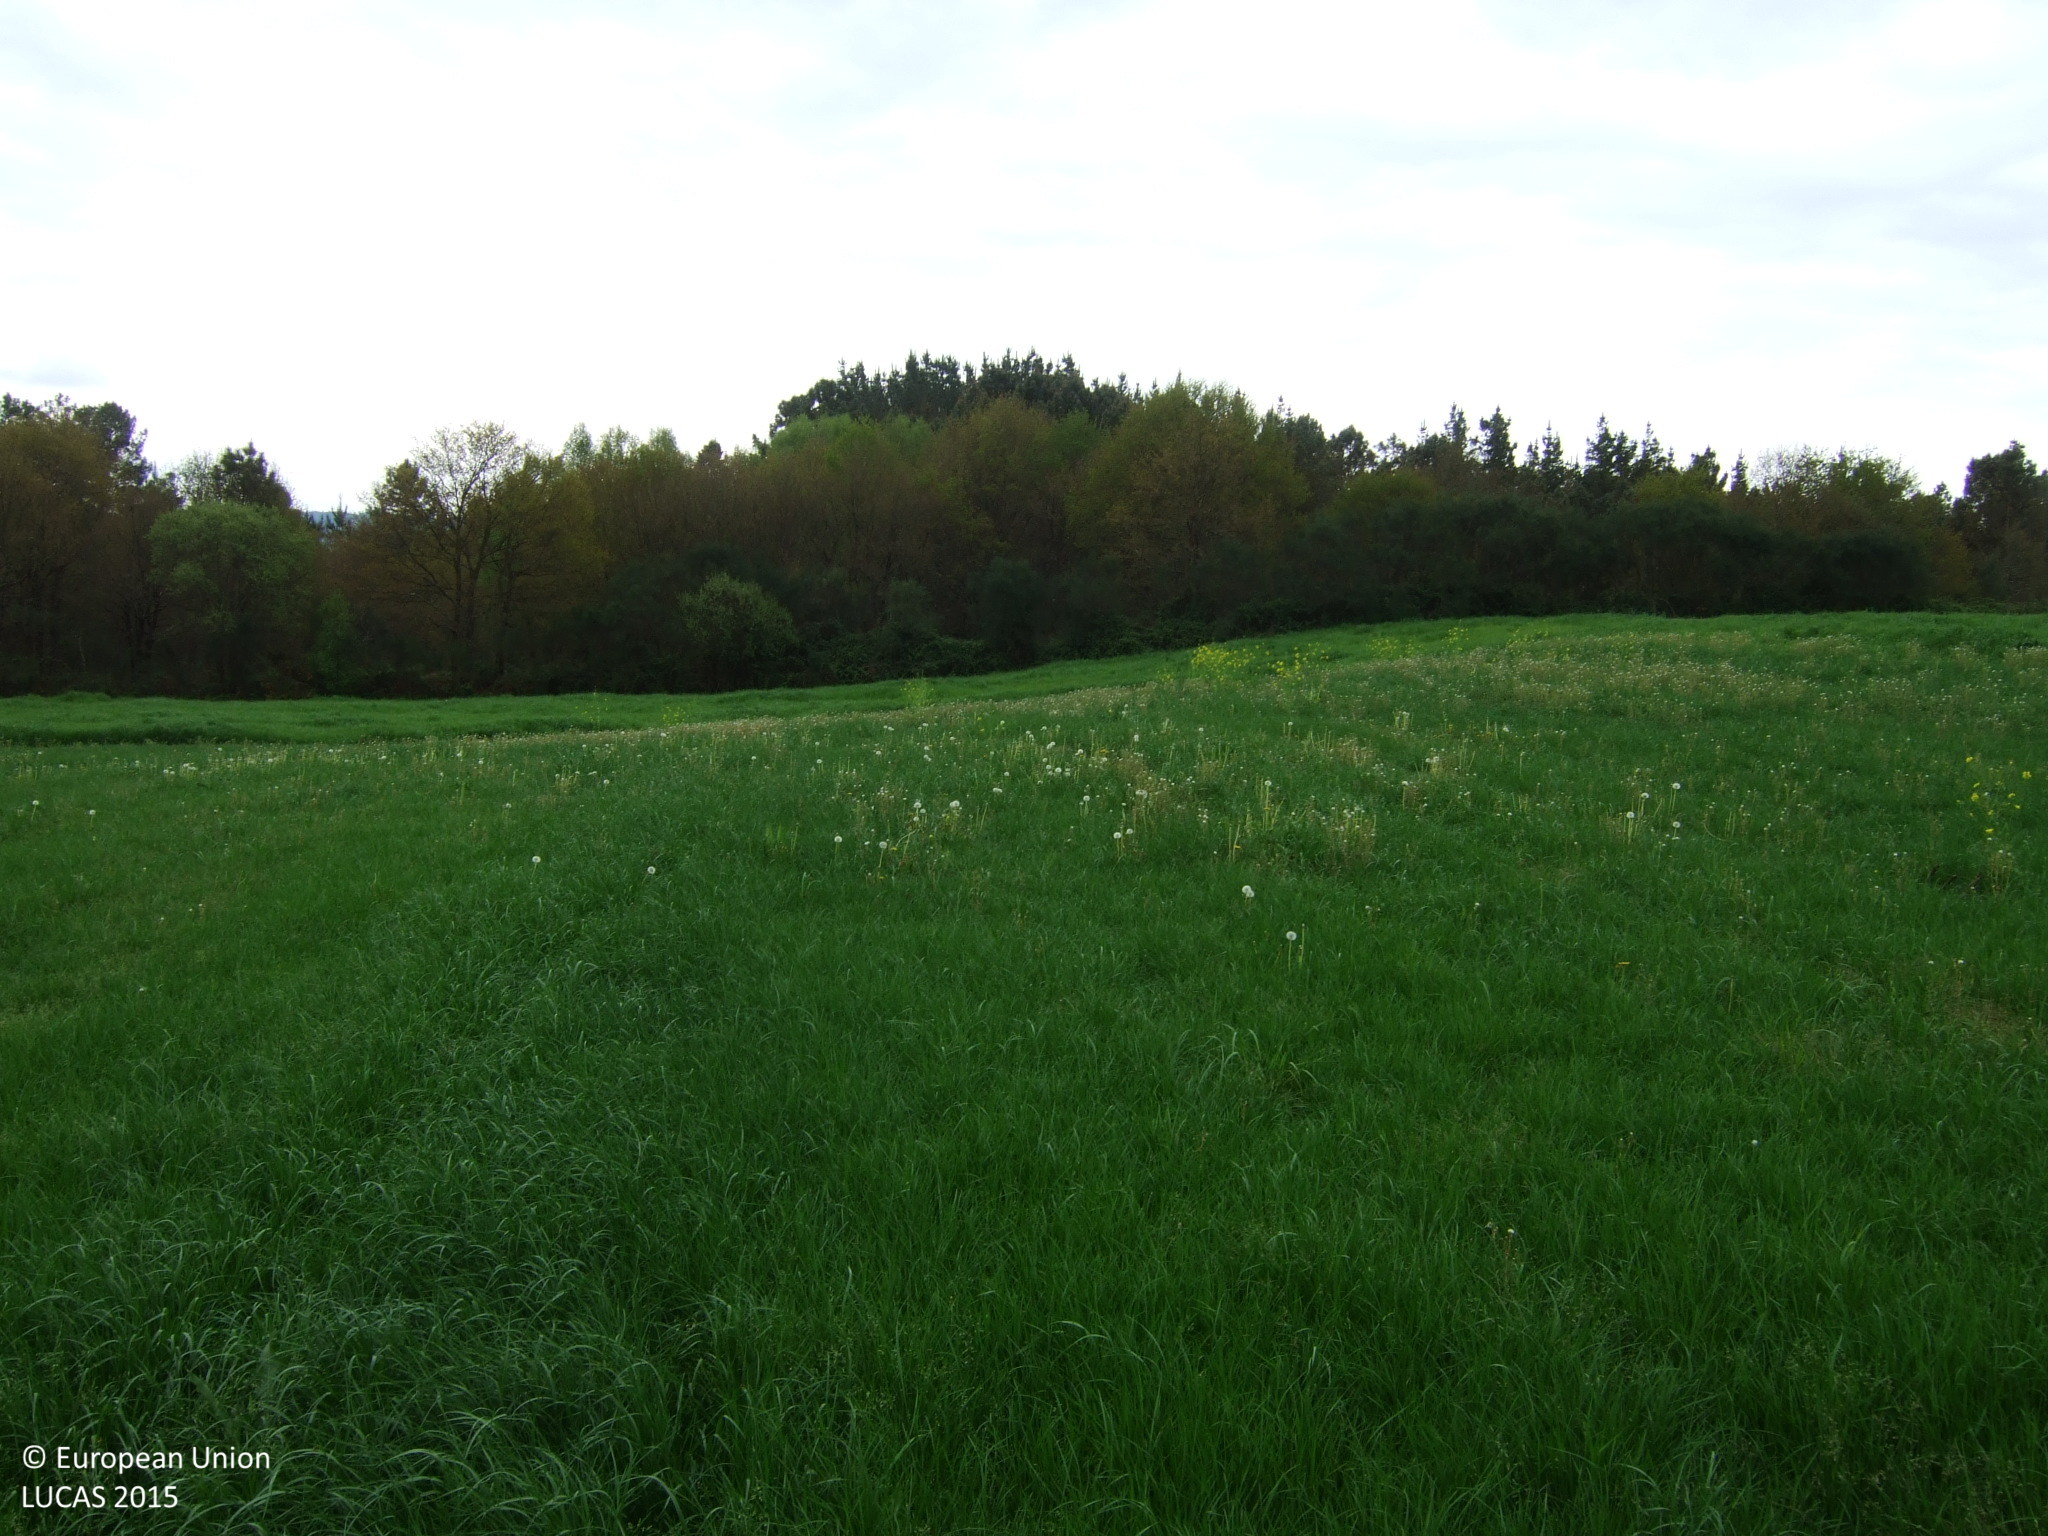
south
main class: Cropland
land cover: Temporary grasslands
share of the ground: > 75 %
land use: Agriculture (excluding fallow land and kitchen gardens)
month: April
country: ES
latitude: 42.8606
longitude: -7.5401
